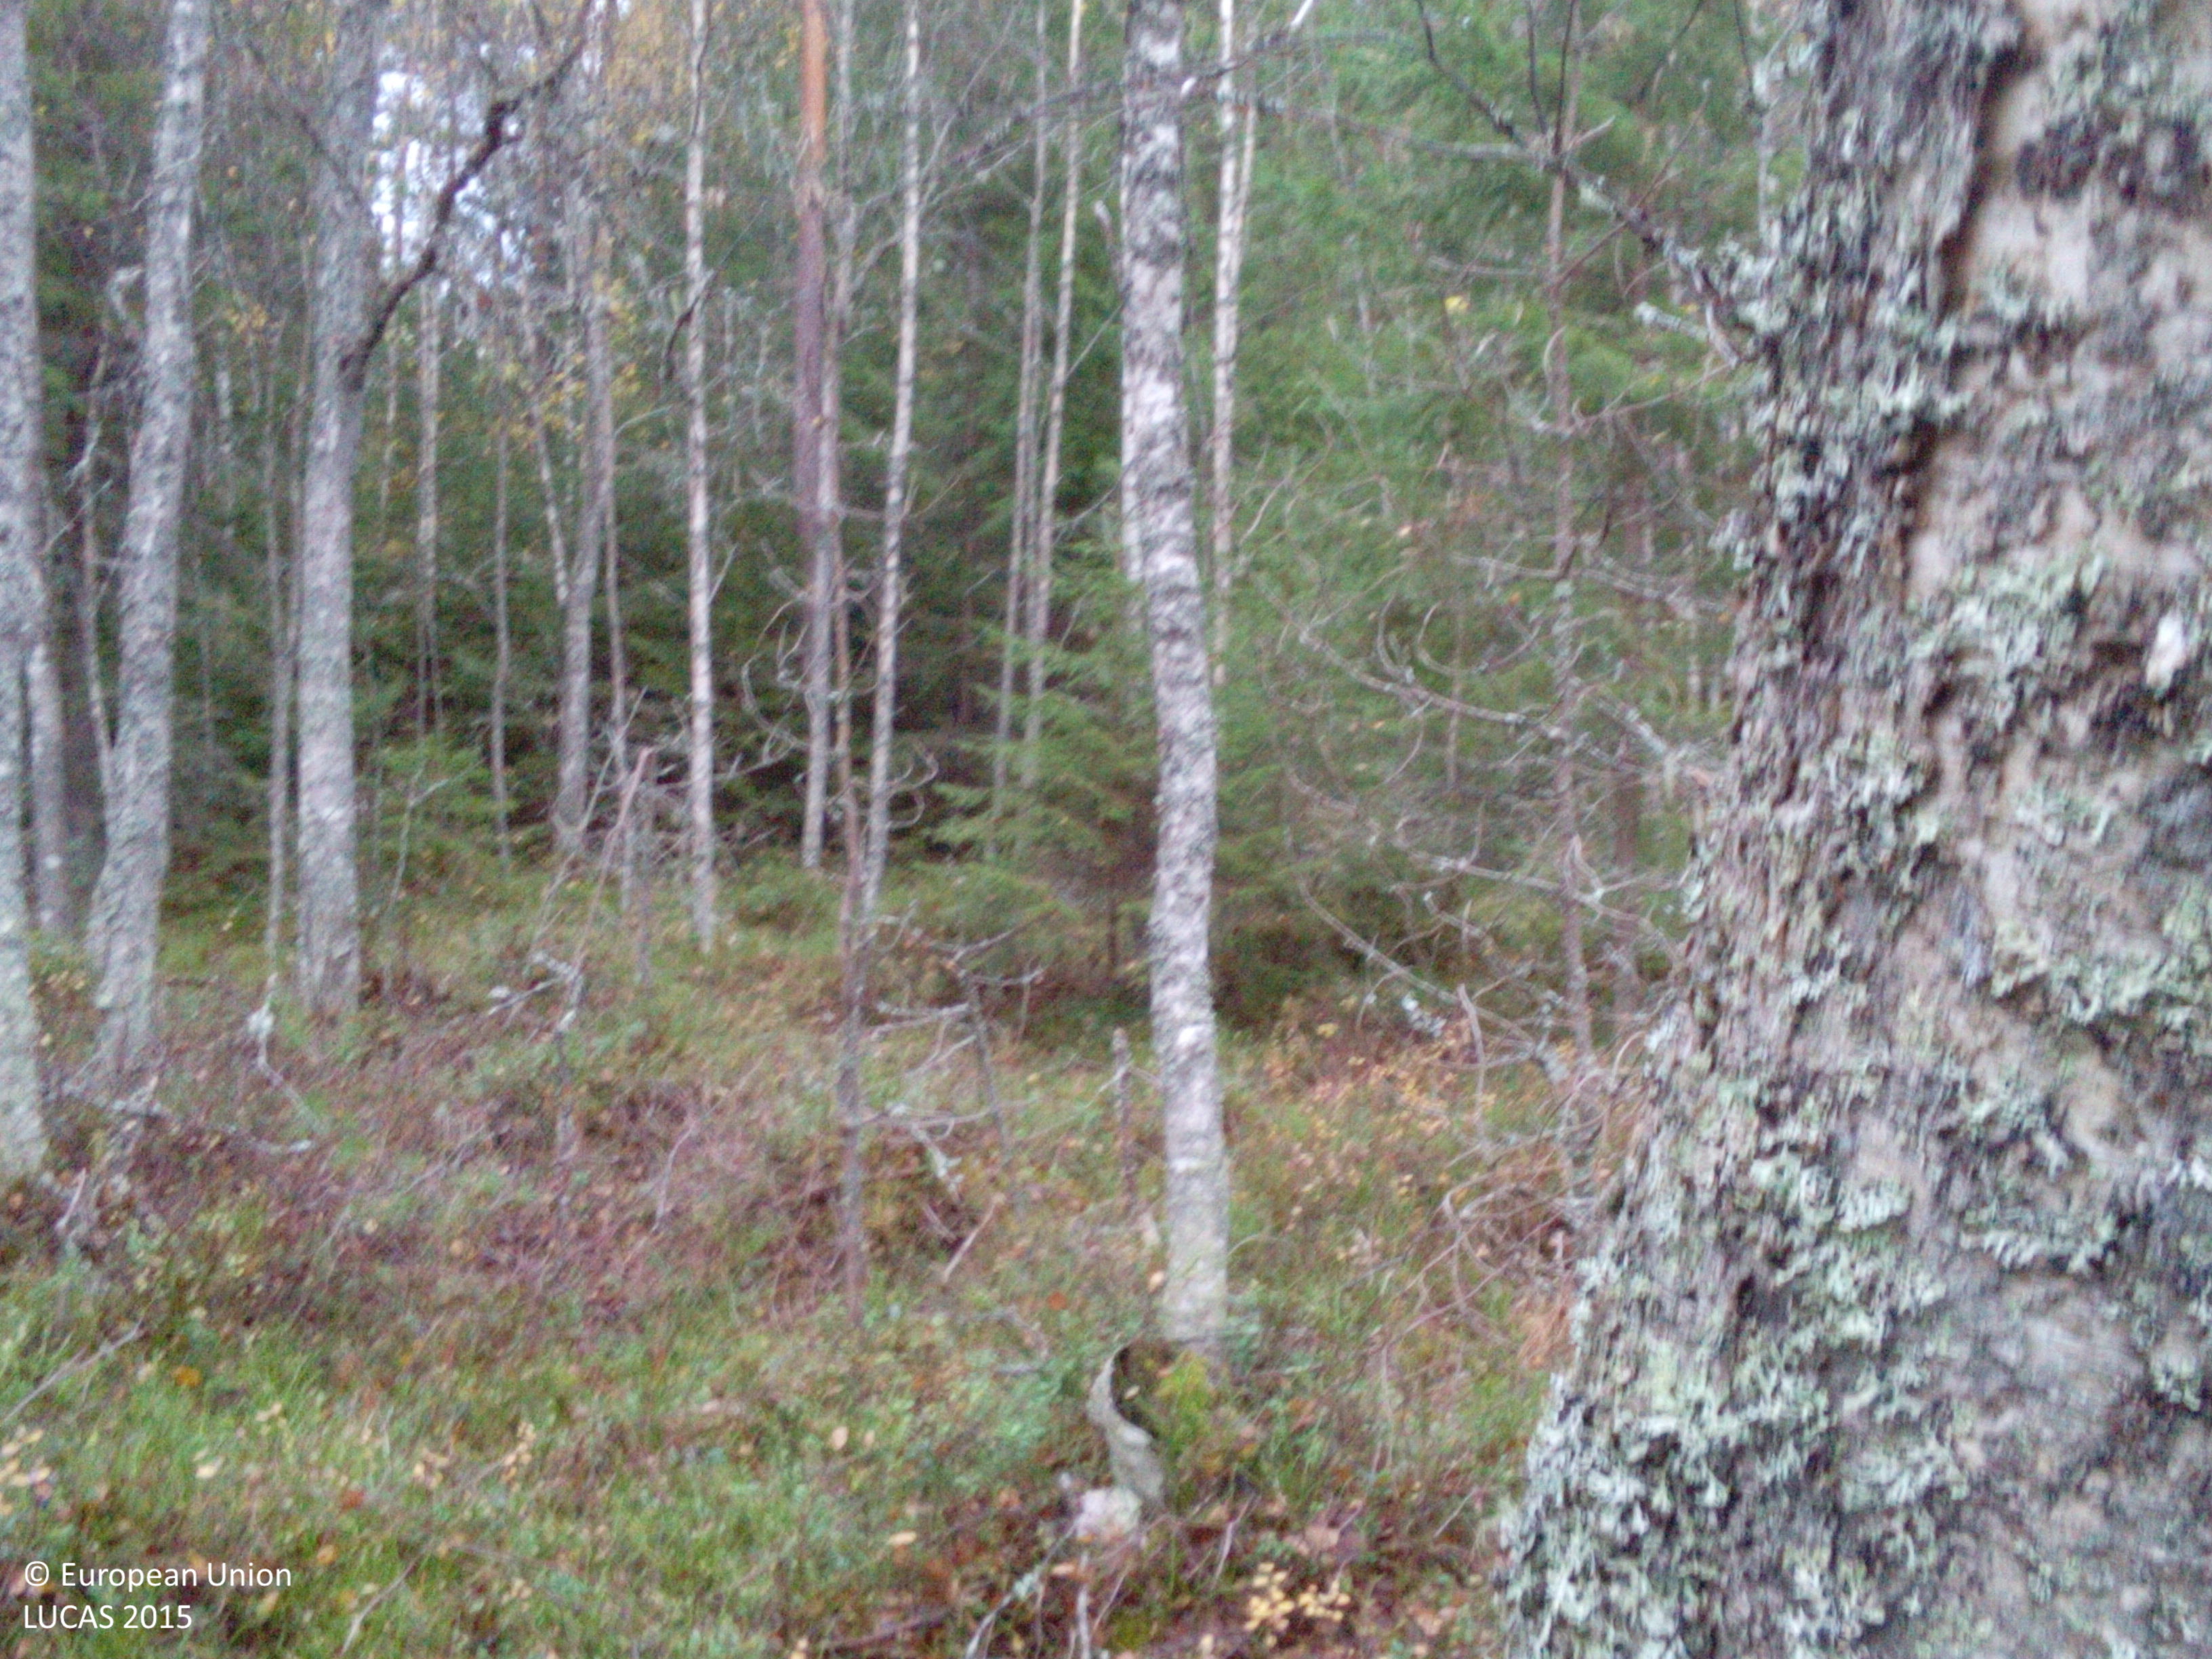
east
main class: Woodland
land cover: Pine dominated mixed woodland
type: boreal forest
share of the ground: > 75 %
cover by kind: coniferous forest trees 40 %, broadleaved forest trees 40 %, herbaceous plants 10 %, lichens and mosses 10 %
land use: Forestry
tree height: > 5 m
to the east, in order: Pine dominated mixed woodland; Spruce dominated mixed woodland; Electric lines; Spruce dominated coniferous woodland; Inland marshes; Broadleaved woodland; Rivers and streams
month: October
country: SE
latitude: 59.2557
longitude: 16.4648
